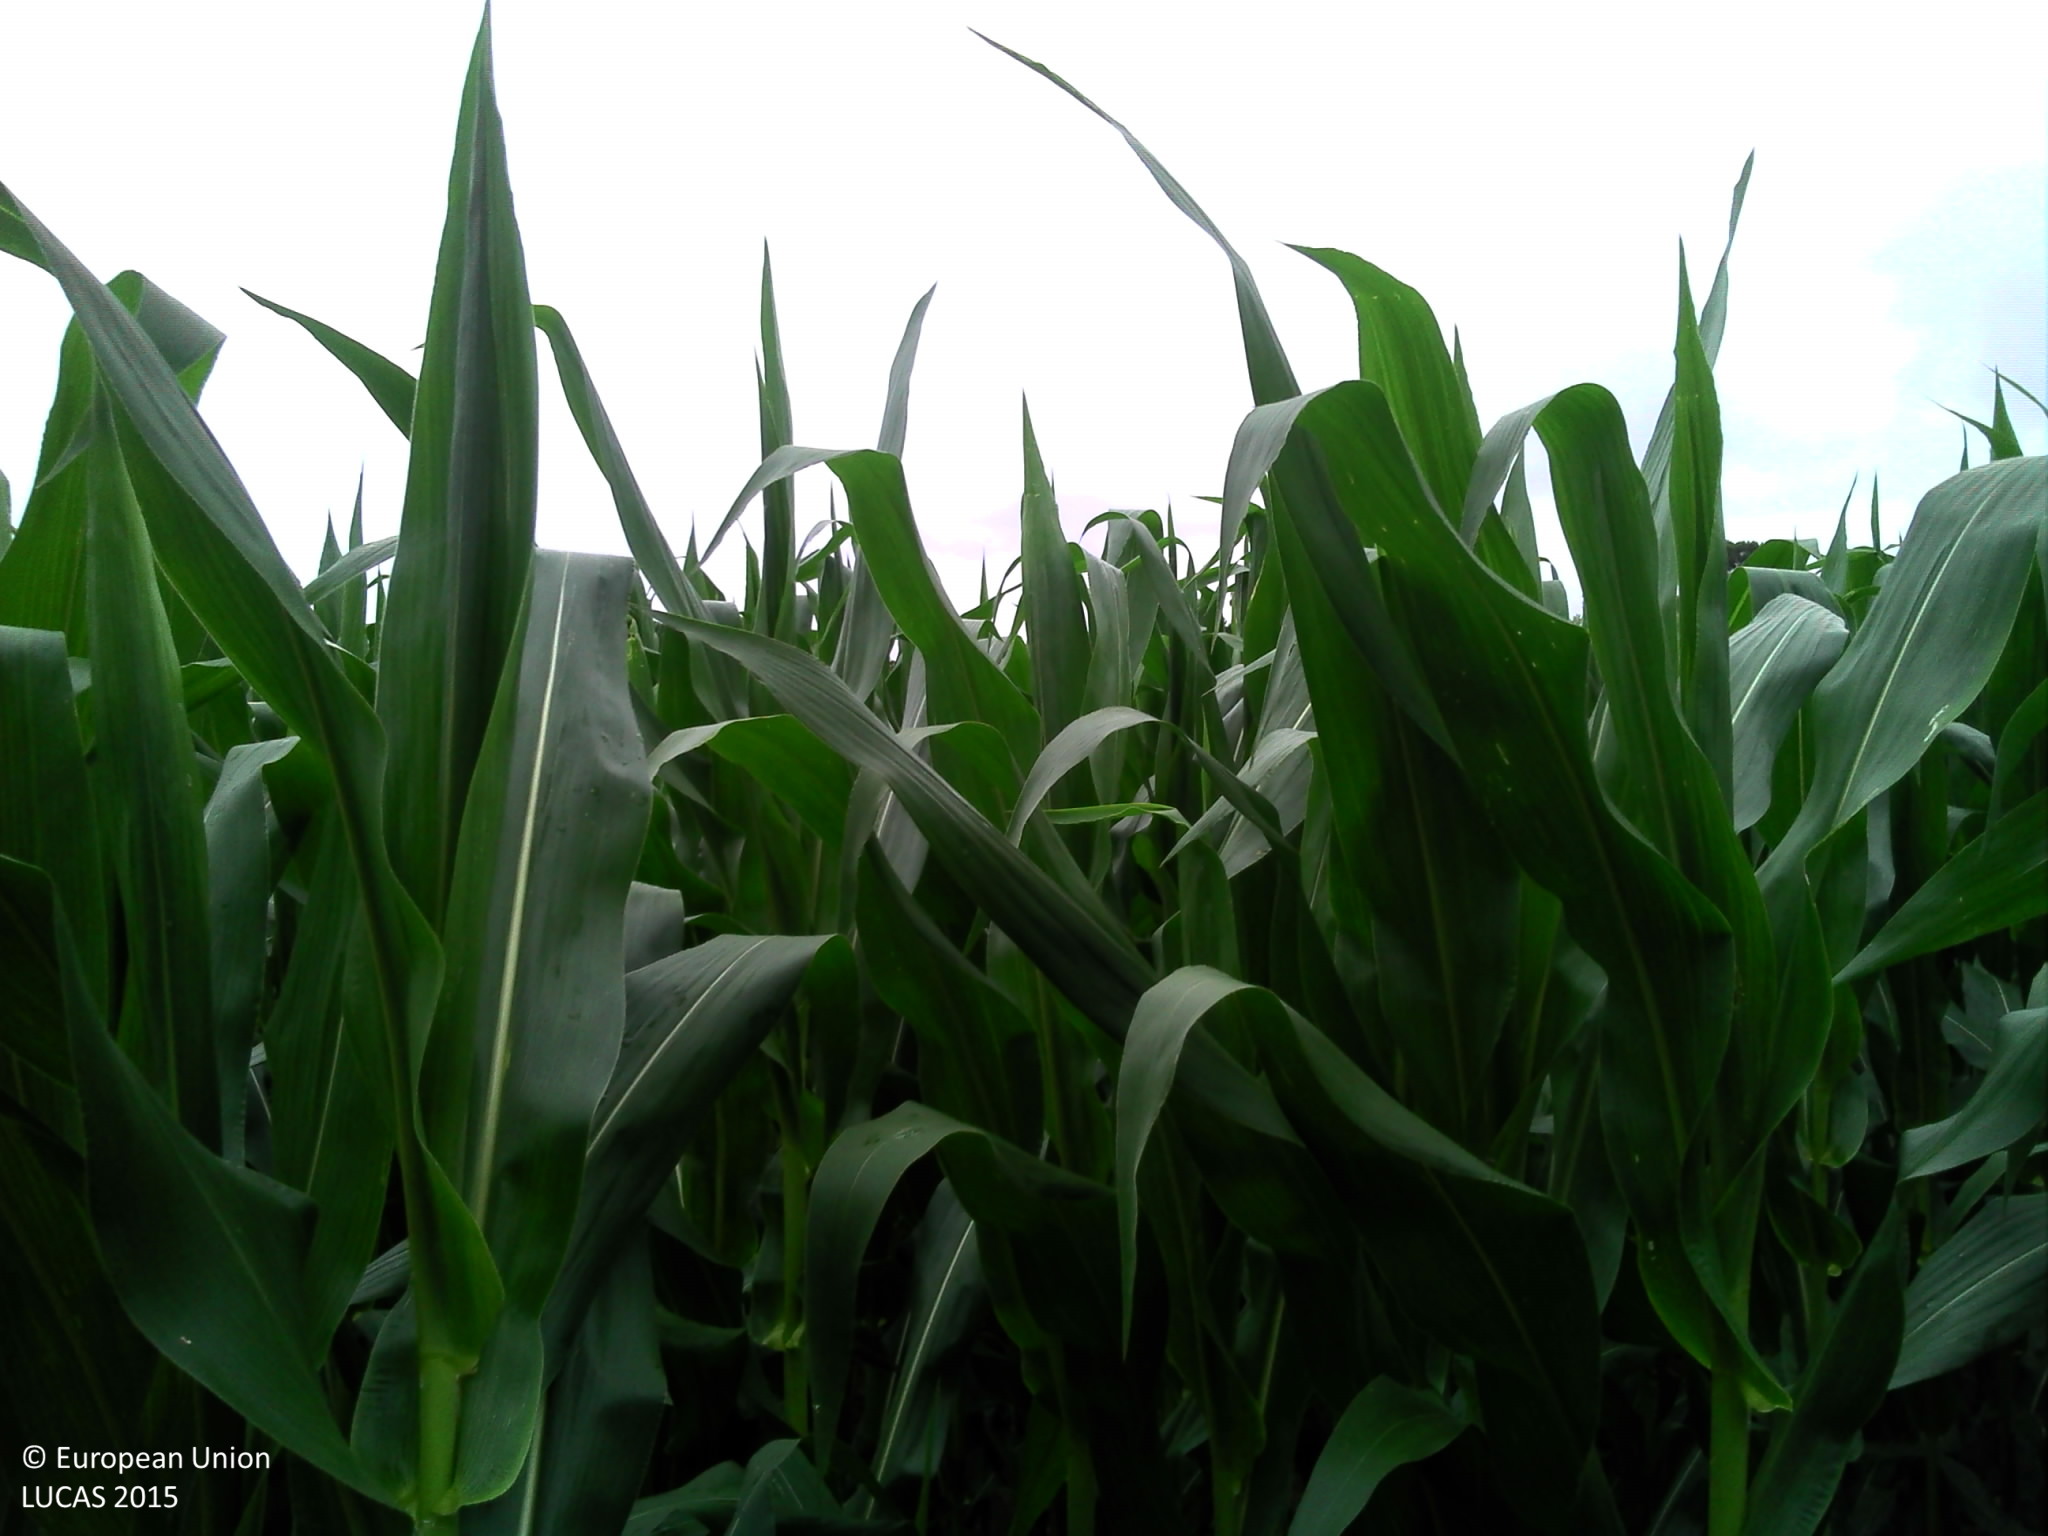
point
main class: Cropland
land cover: Maize
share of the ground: > 75 %
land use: Agriculture (excluding fallow land and kitchen gardens)
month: July
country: FR
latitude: 43.6677
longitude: -1.2159
